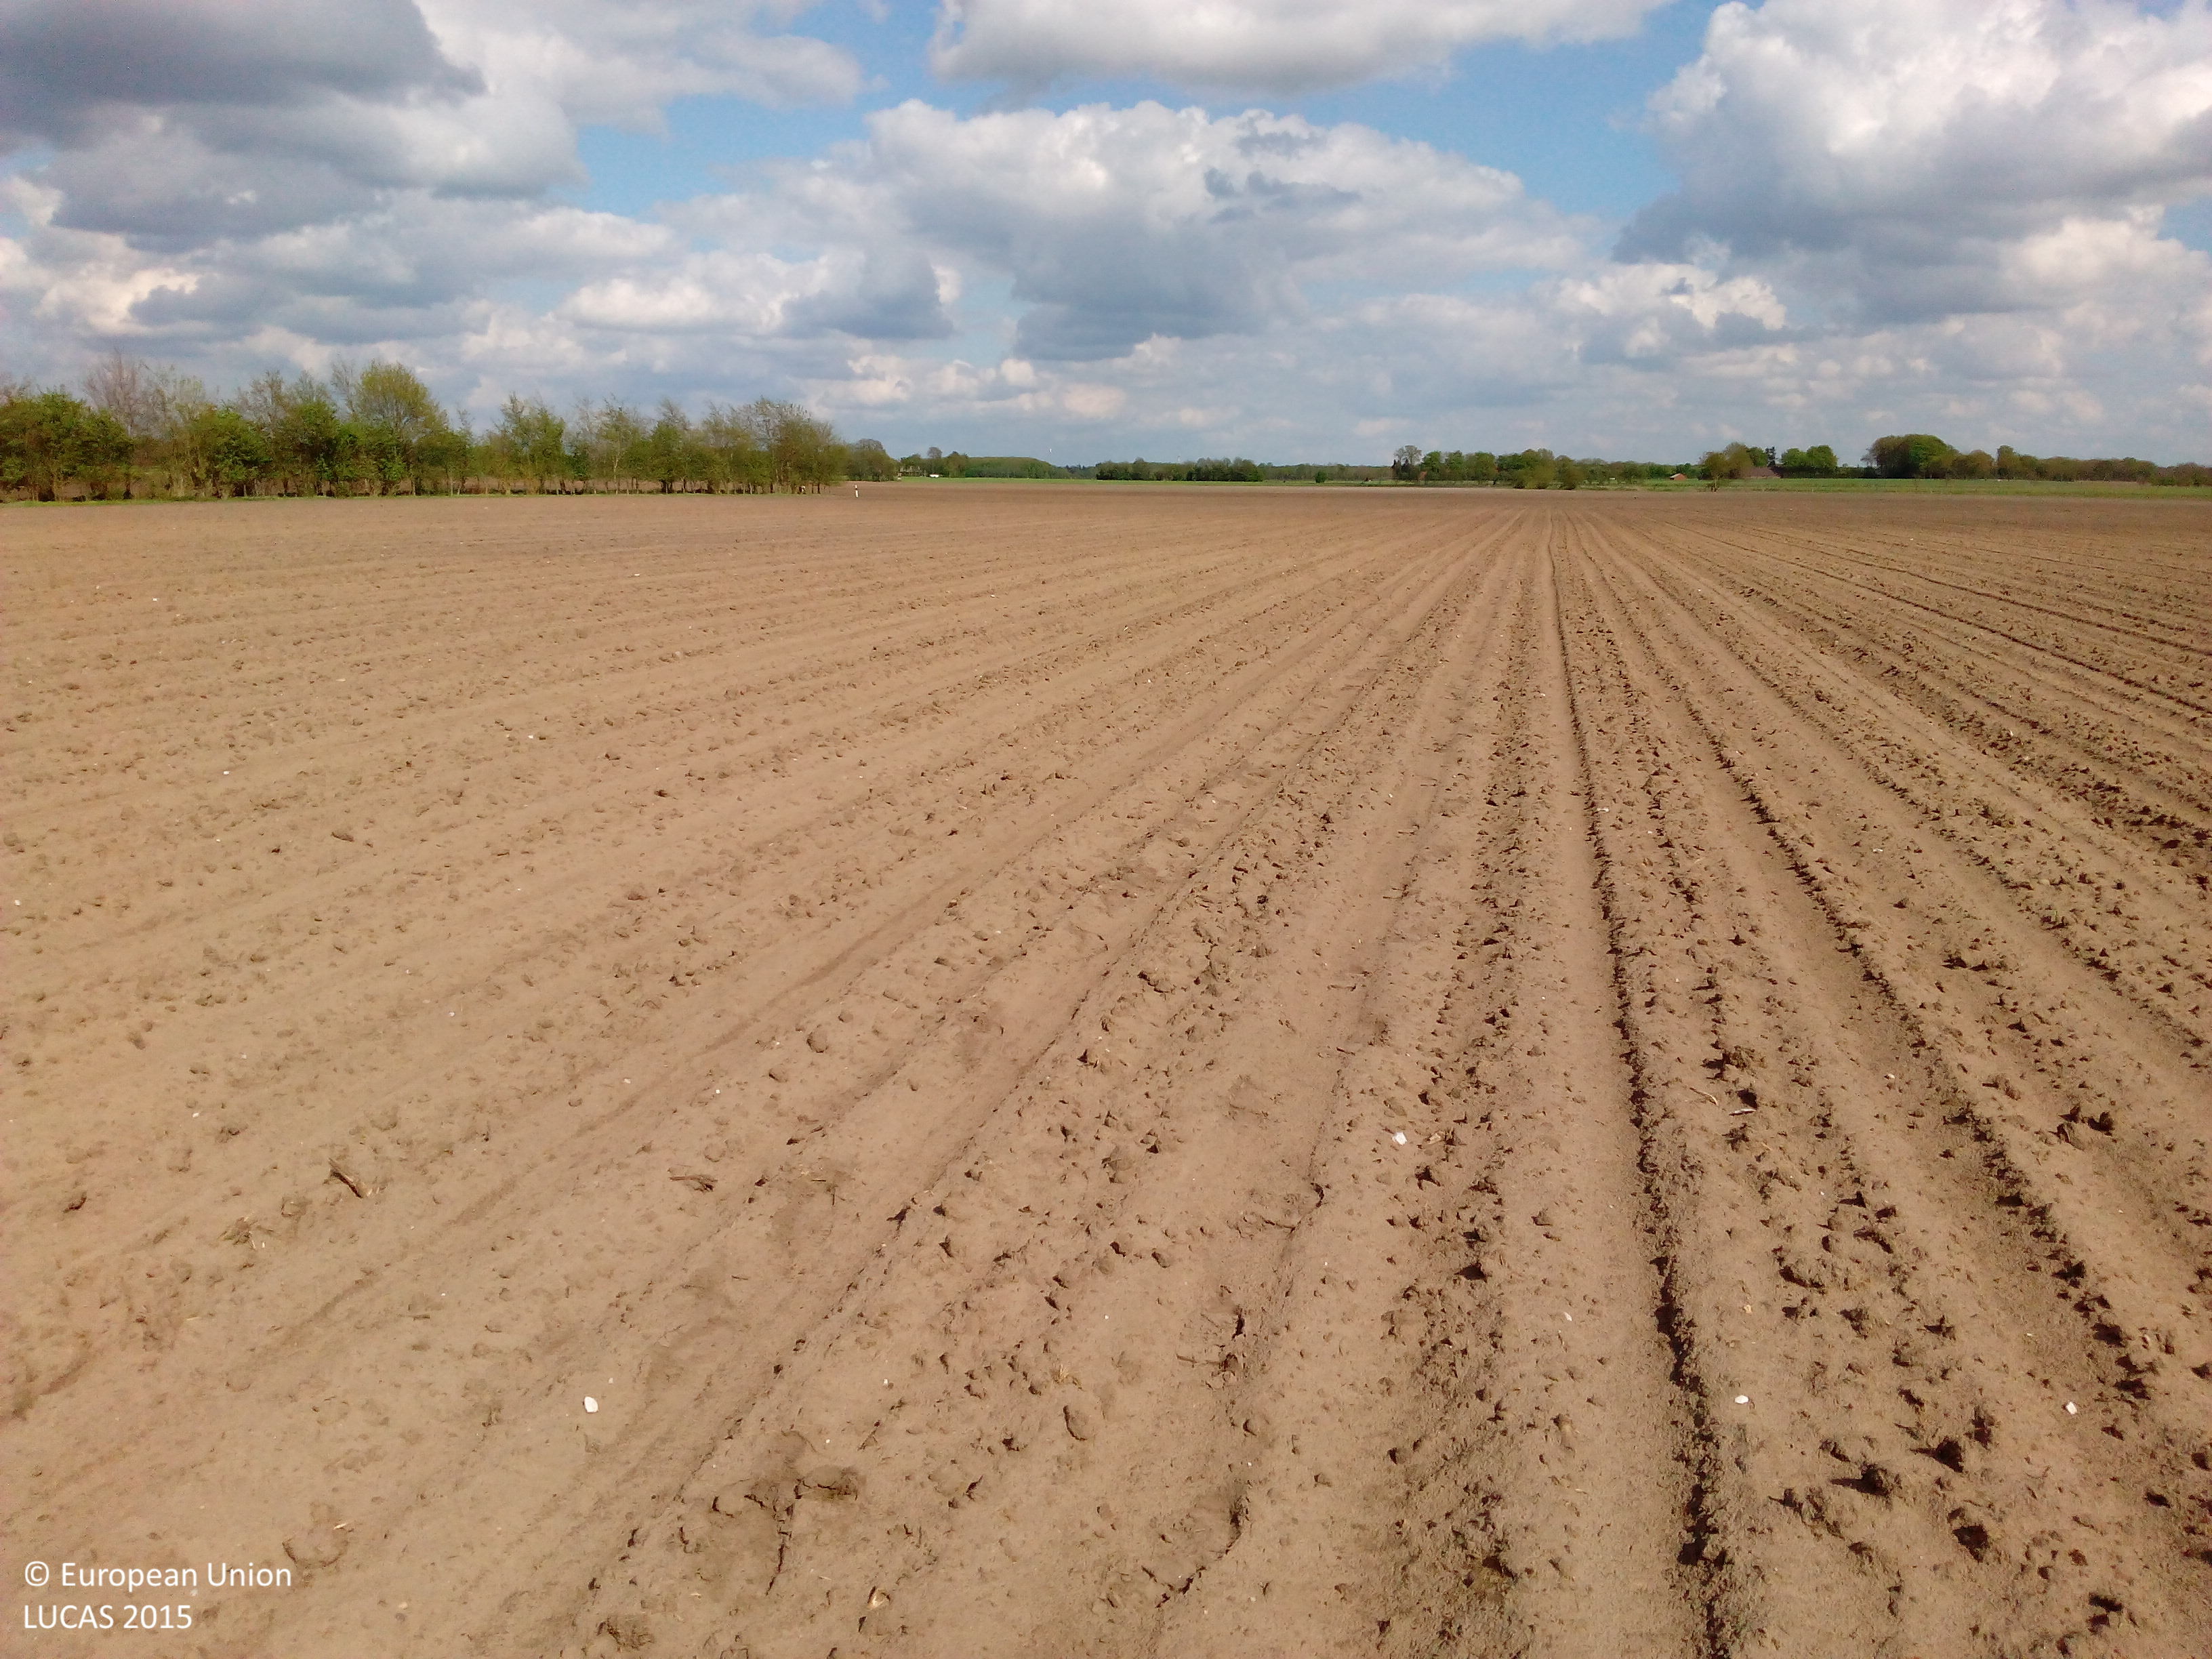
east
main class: Cropland
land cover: Sugar beet
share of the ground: < 10 %
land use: Agriculture (excluding fallow land and kitchen gardens)
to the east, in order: Sugar beet; Maize
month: May
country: DE
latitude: 52.9179
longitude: 7.9928
